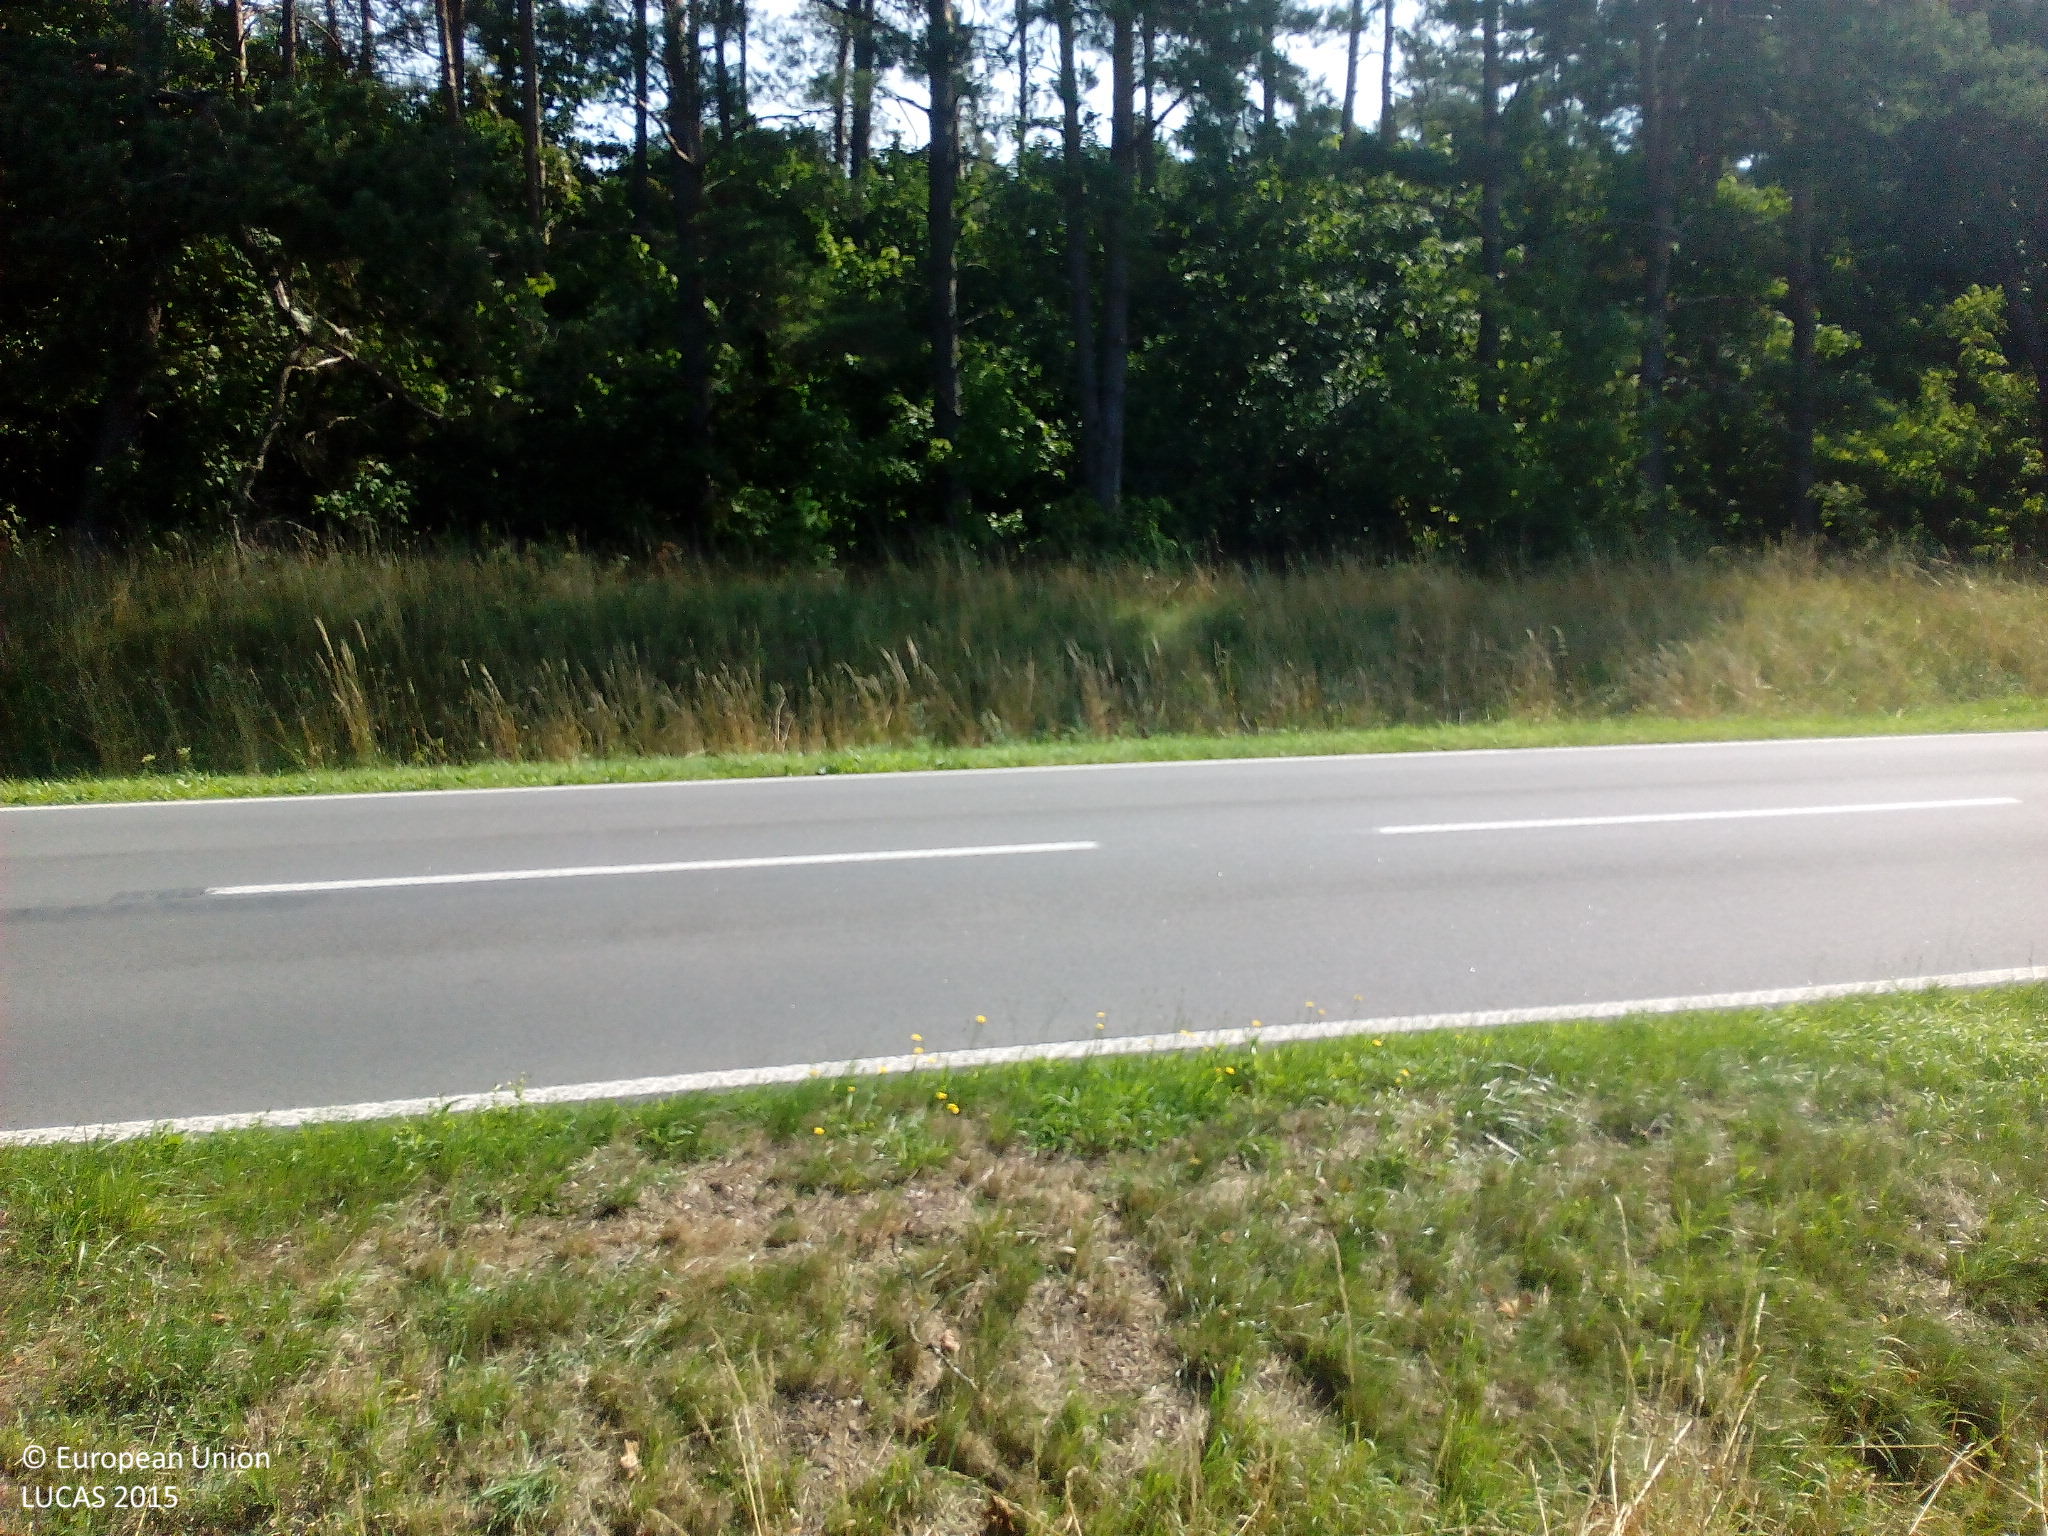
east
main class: Cropland
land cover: Maize
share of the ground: > 75 %
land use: Agriculture (excluding fallow land and kitchen gardens)
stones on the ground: 10 - 25 %
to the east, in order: Maize; Ditches and canals; Lines of trees; Paved roads, cycling and walking lanes; Grass margins
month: August
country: DE
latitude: 53.6107
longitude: 12.4630
